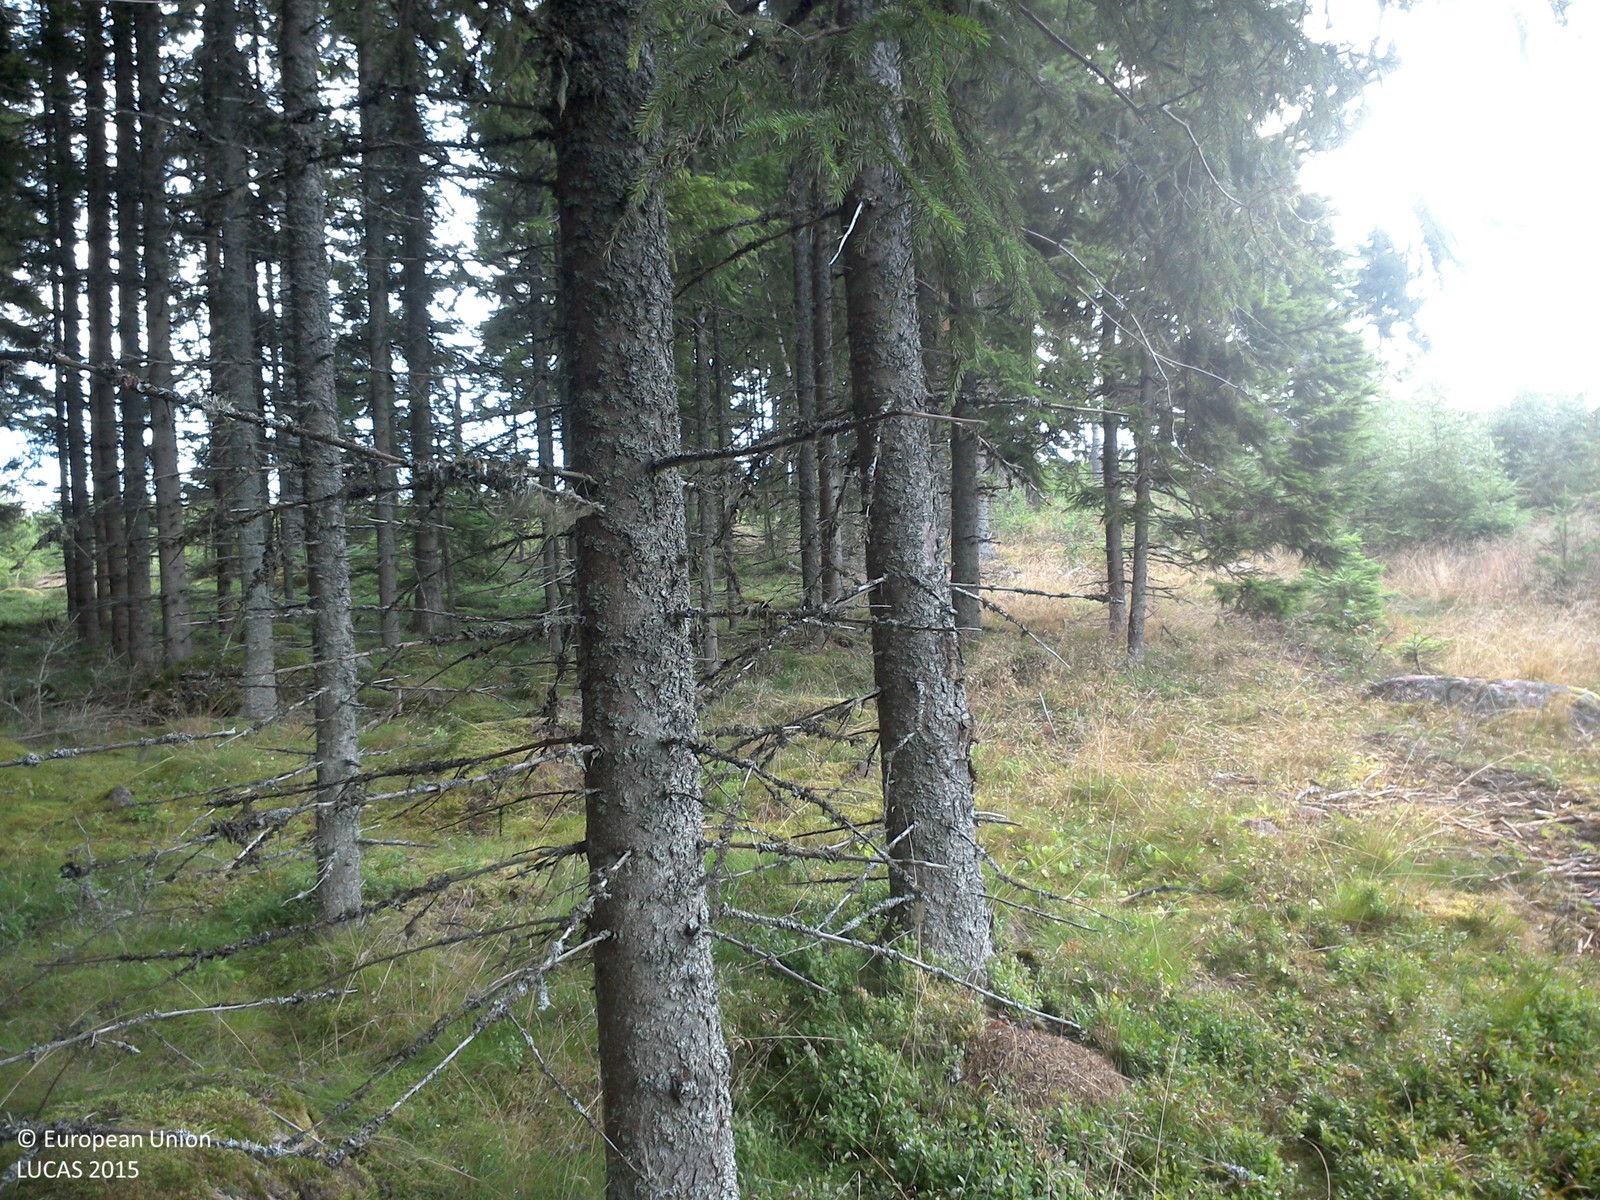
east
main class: Woodland
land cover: Spruce dominated coniferous woodland
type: boreal forest
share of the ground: > 75 %
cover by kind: coniferous forest trees 90 %, lichens and mosses 5 %, unconsolidated bare surface 5 %
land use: Forestry
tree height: > 5 m
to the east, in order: Spruce dominated coniferous woodland; Broadleaved woodland; Grassland with sparse tree/shrub cover; Electric lines; Grassland with sparse tree/shrub cover; Spruce dominated coniferous woodland; Spruce dominated mixed woodland; Ditches and canals; Paved roads, cycling and walking lanes; Spruce dominated coniferous woodland
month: August
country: SE
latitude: 57.7755
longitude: 15.2249
